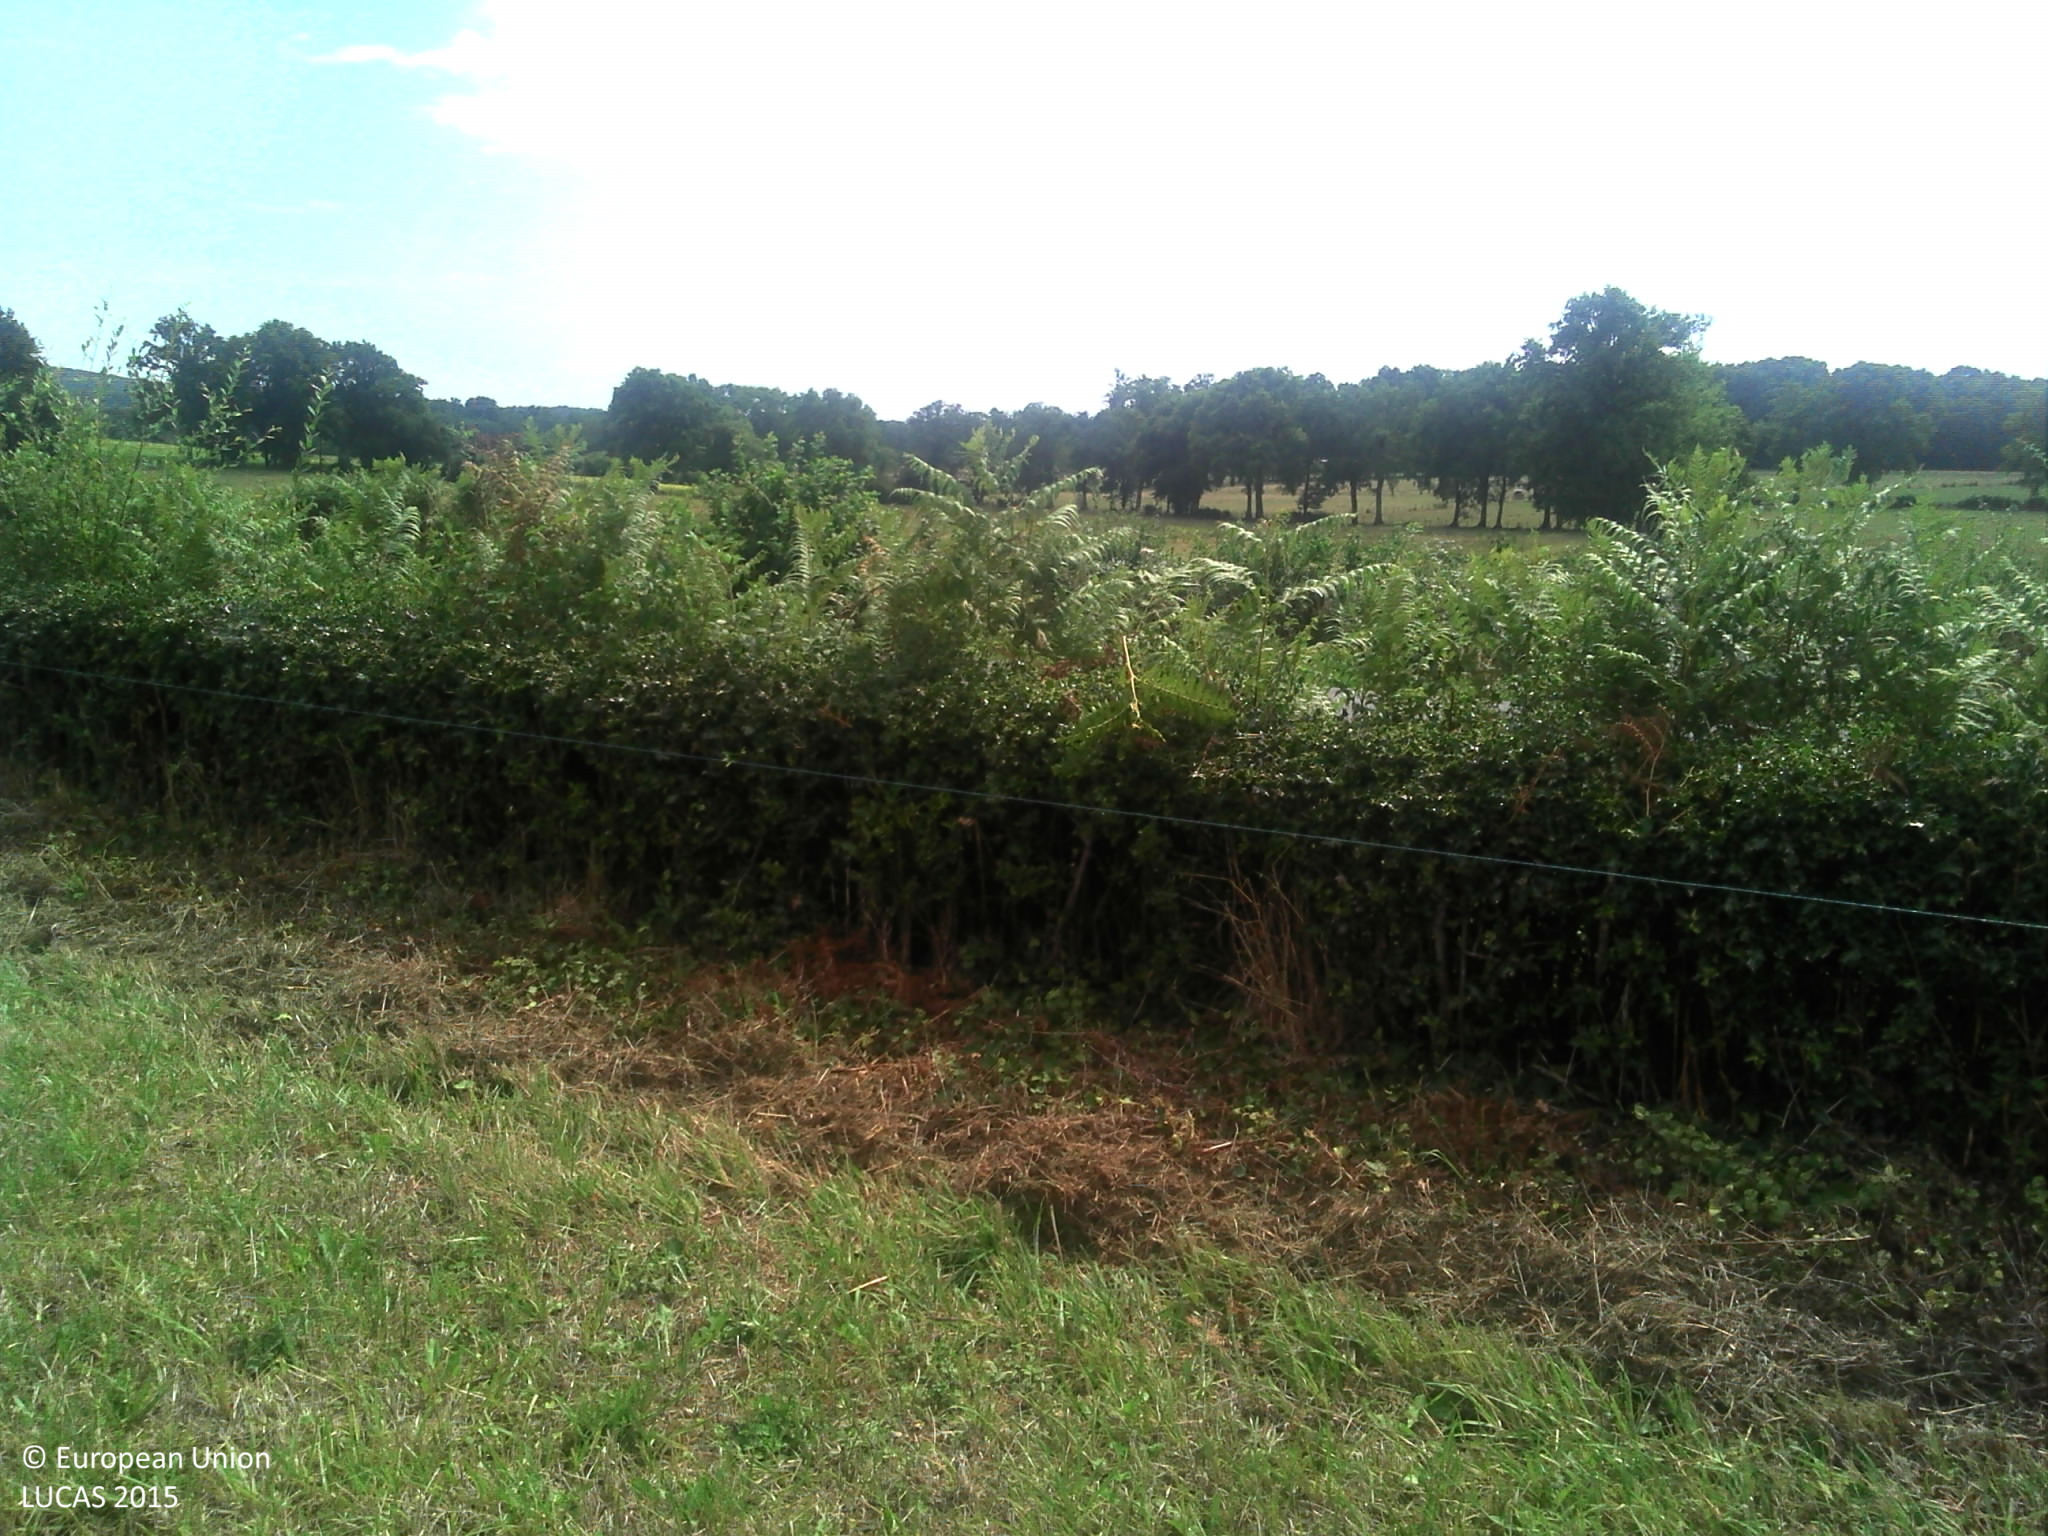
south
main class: Grassland
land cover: Grassland without tree/shrub cover
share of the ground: > 75 %
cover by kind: herbaceous plants 100 %
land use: Agriculture (excluding fallow land and kitchen gardens)
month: August
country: FR
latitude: 46.0555
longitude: 0.9270
